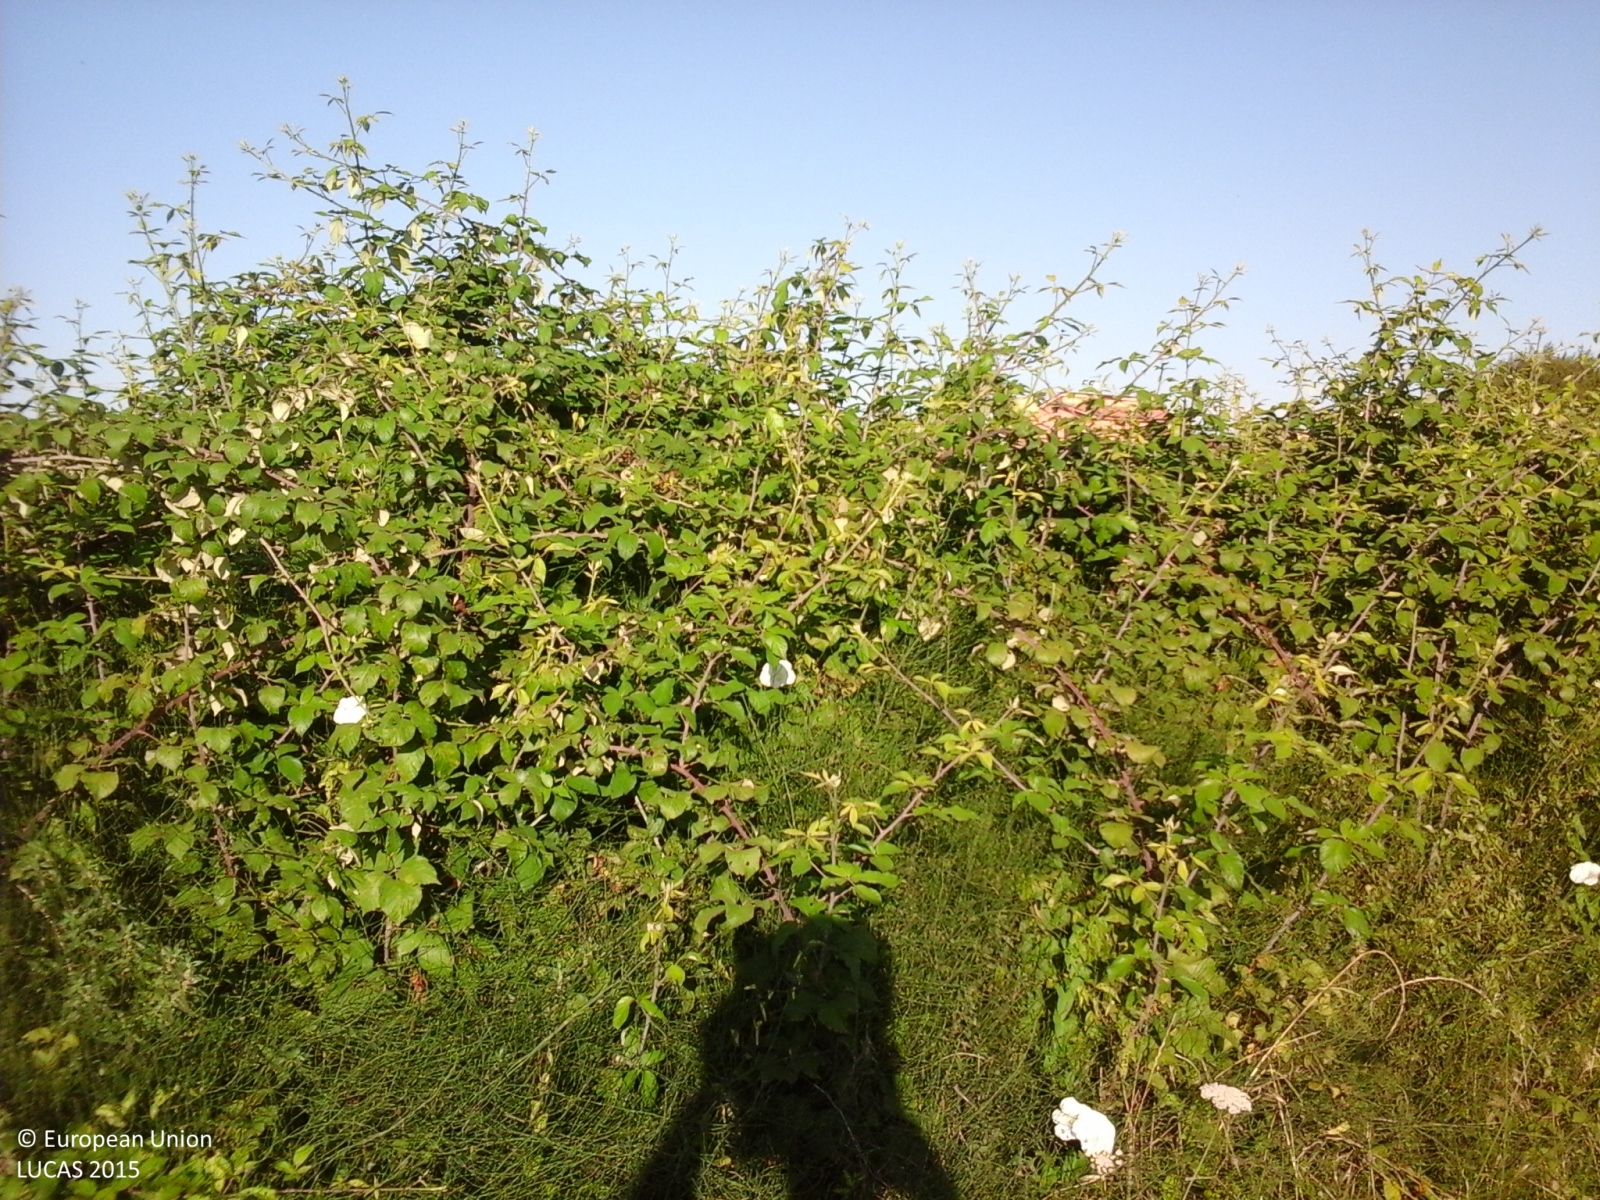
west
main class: Grassland
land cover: Spontaneously vegetated surfaces
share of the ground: > 75 %
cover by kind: herbaceous plants 100 %
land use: Fallow land
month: July
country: IT
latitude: 43.1615
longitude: 13.7906
